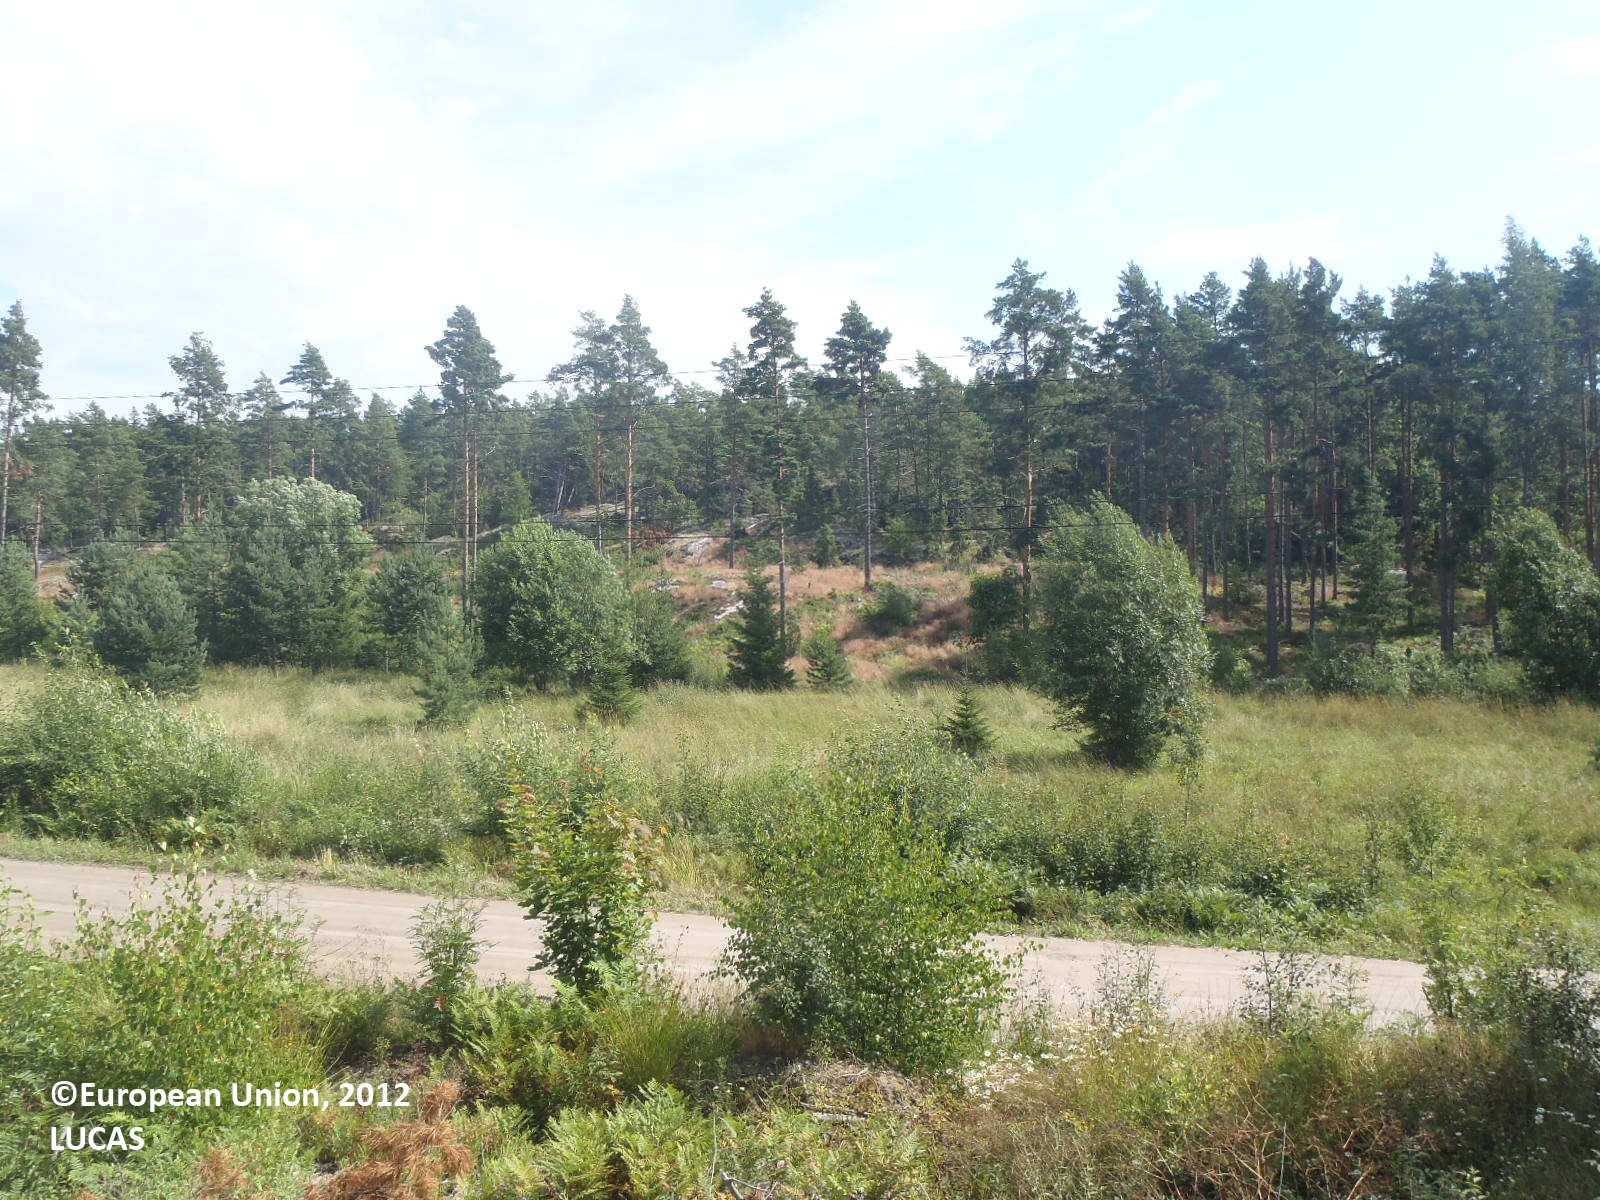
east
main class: Woodland
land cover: Pine dominated mixed woodland
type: boreal forest
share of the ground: 10 - 25 %
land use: Forestry
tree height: > 5 m
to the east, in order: Pine dominated mixed woodland; Paved roads, cycling and walking lanes; Grass margins; Abandoned hedges; Ditches and canals; Grassland without tree/shrub cover; Electric lines; Grassland with sparse tree/shrub cover; Pine dominated mixed woodland
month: July
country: FI
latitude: 60.4324
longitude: 21.9997
